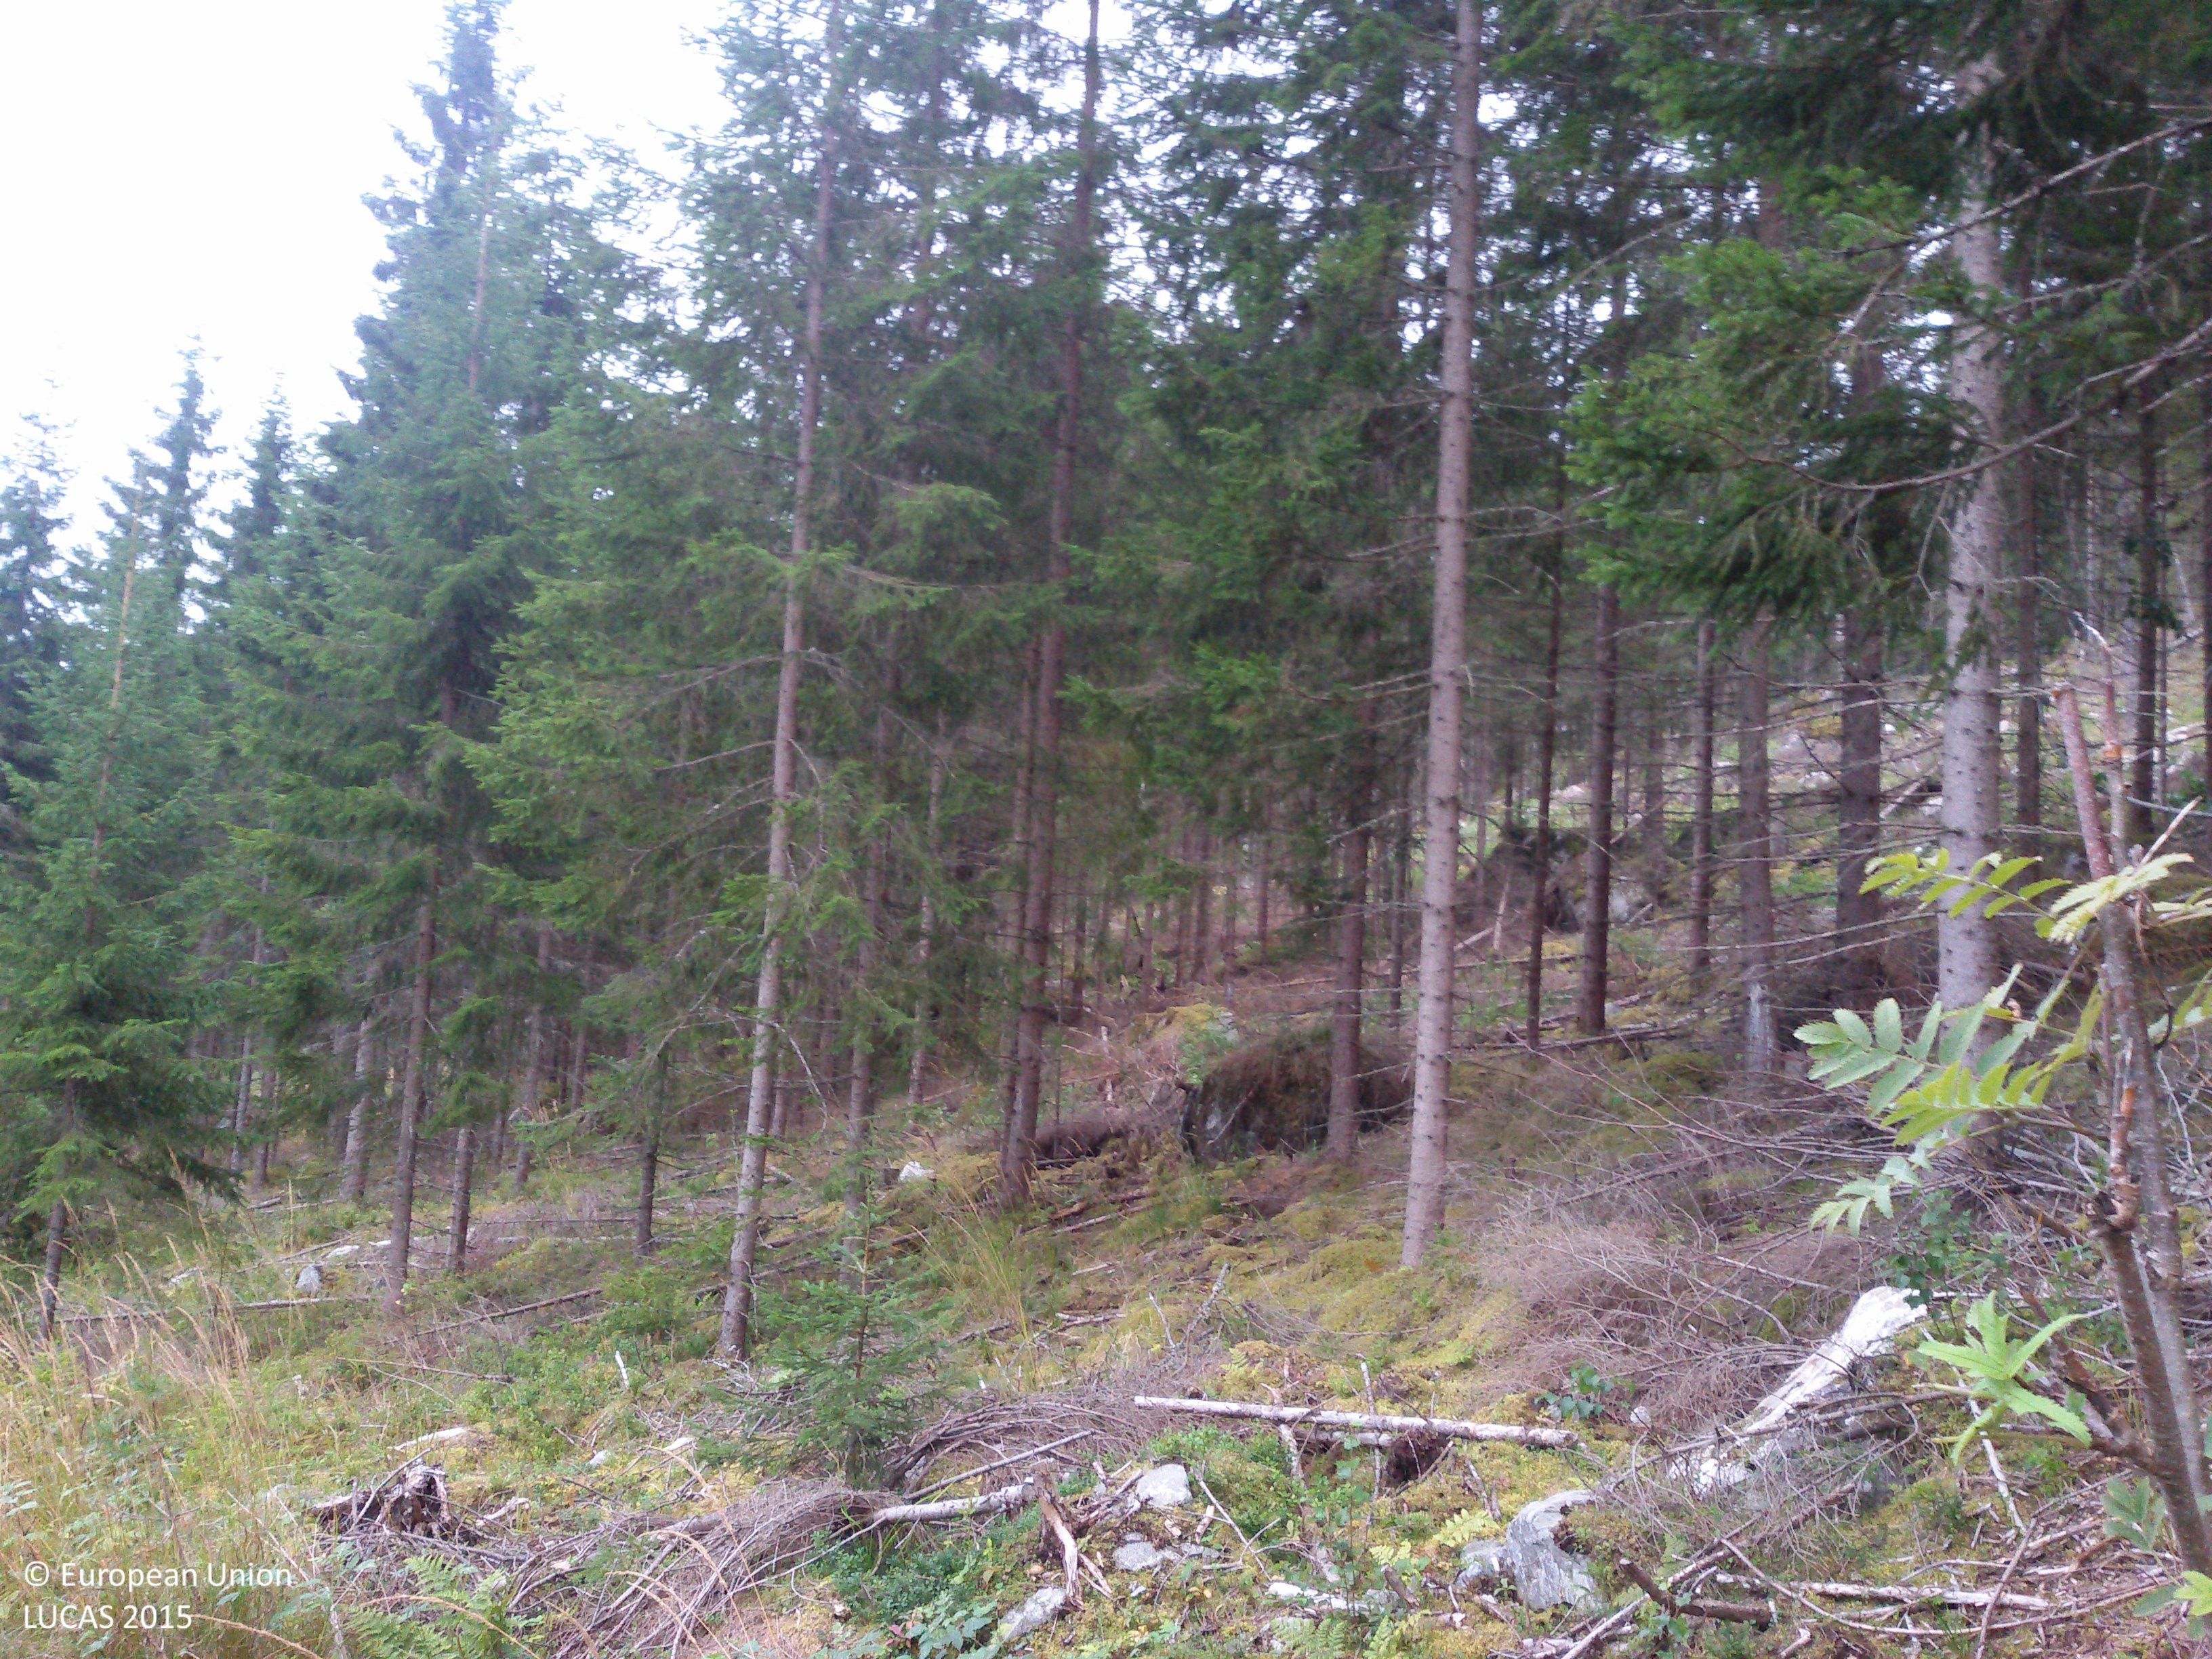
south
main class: Woodland
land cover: Spruce dominated coniferous woodland
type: boreal forest
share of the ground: 10 - 25 %
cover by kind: herbaceous plants 70 %, coniferous forest trees 20 %
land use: Forestry
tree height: > 5 m
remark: Nursery
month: September
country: SE
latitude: 60.9327
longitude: 15.6877
